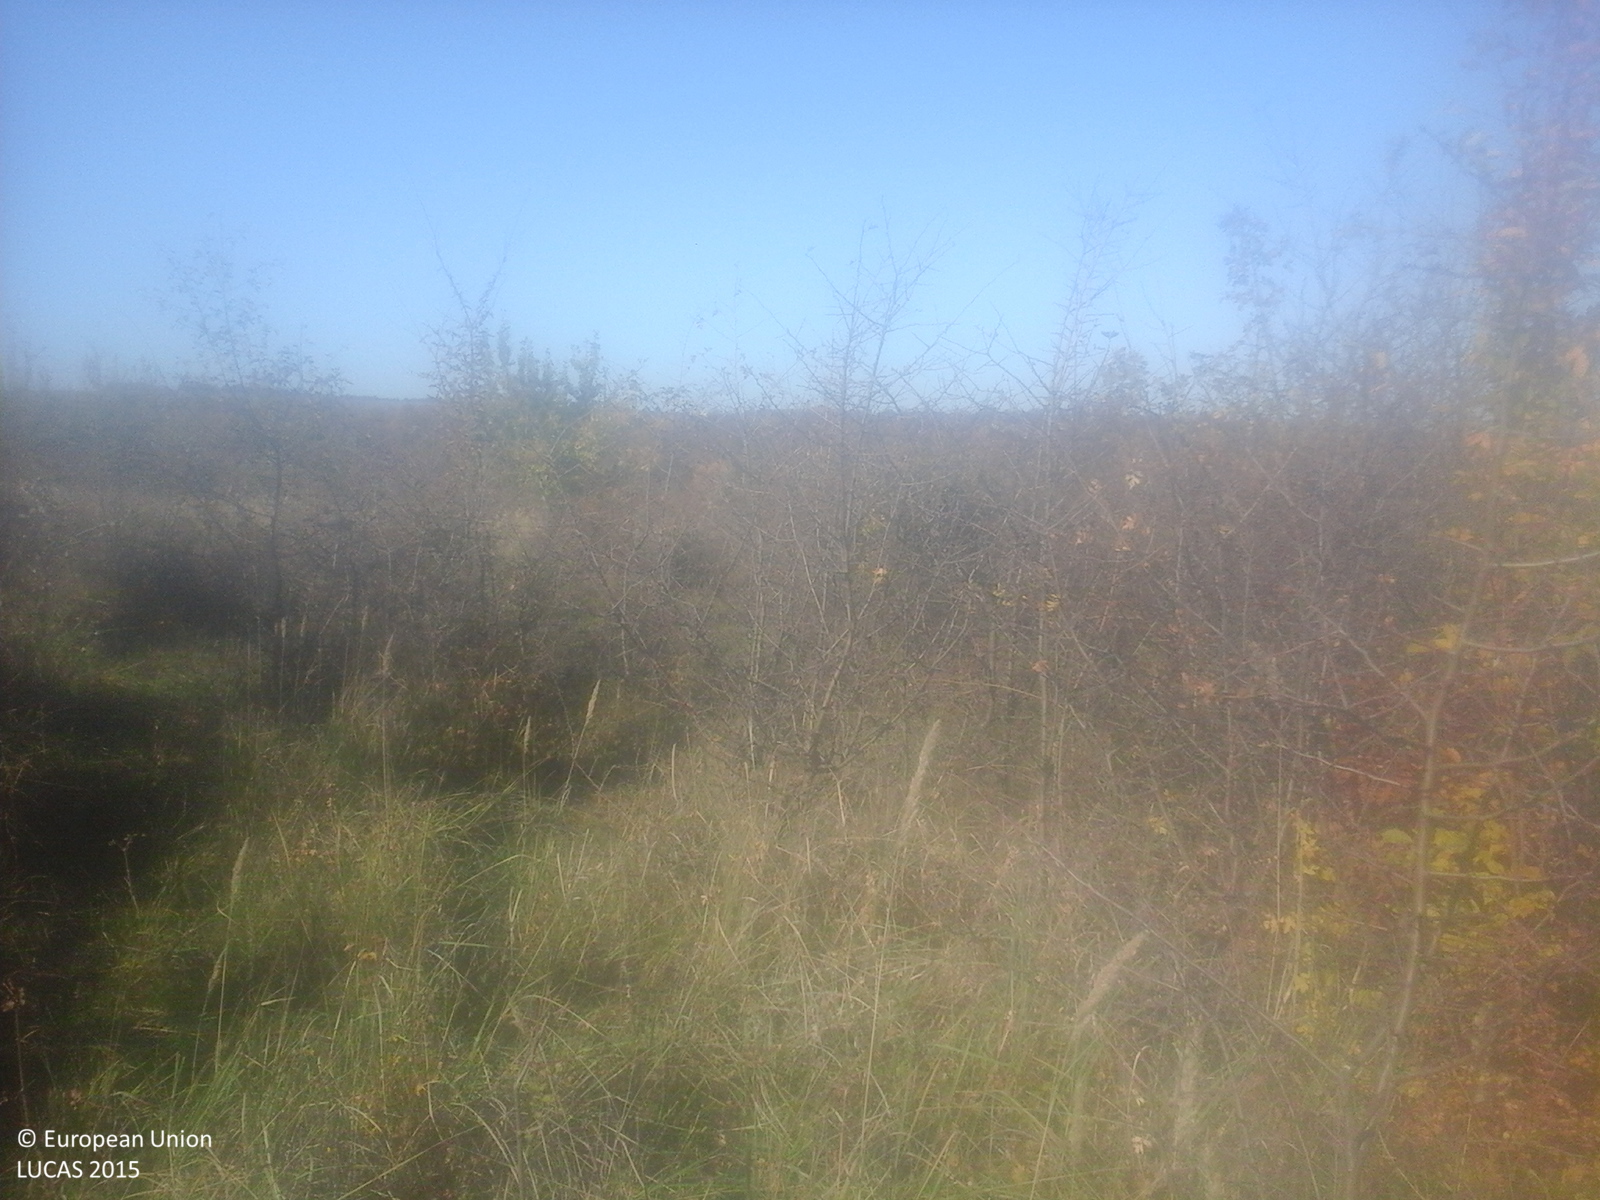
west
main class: Shrubland
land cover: Shrubland with sparse tree cover
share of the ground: > 75 %
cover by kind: shrubs 70 %, herbaceous plants 25 %, broadleaved forest trees 5 %
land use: Agriculture (excluding fallow land and kitchen gardens)
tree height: < 5 m
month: October
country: RO
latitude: 45.9124
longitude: 27.0192
